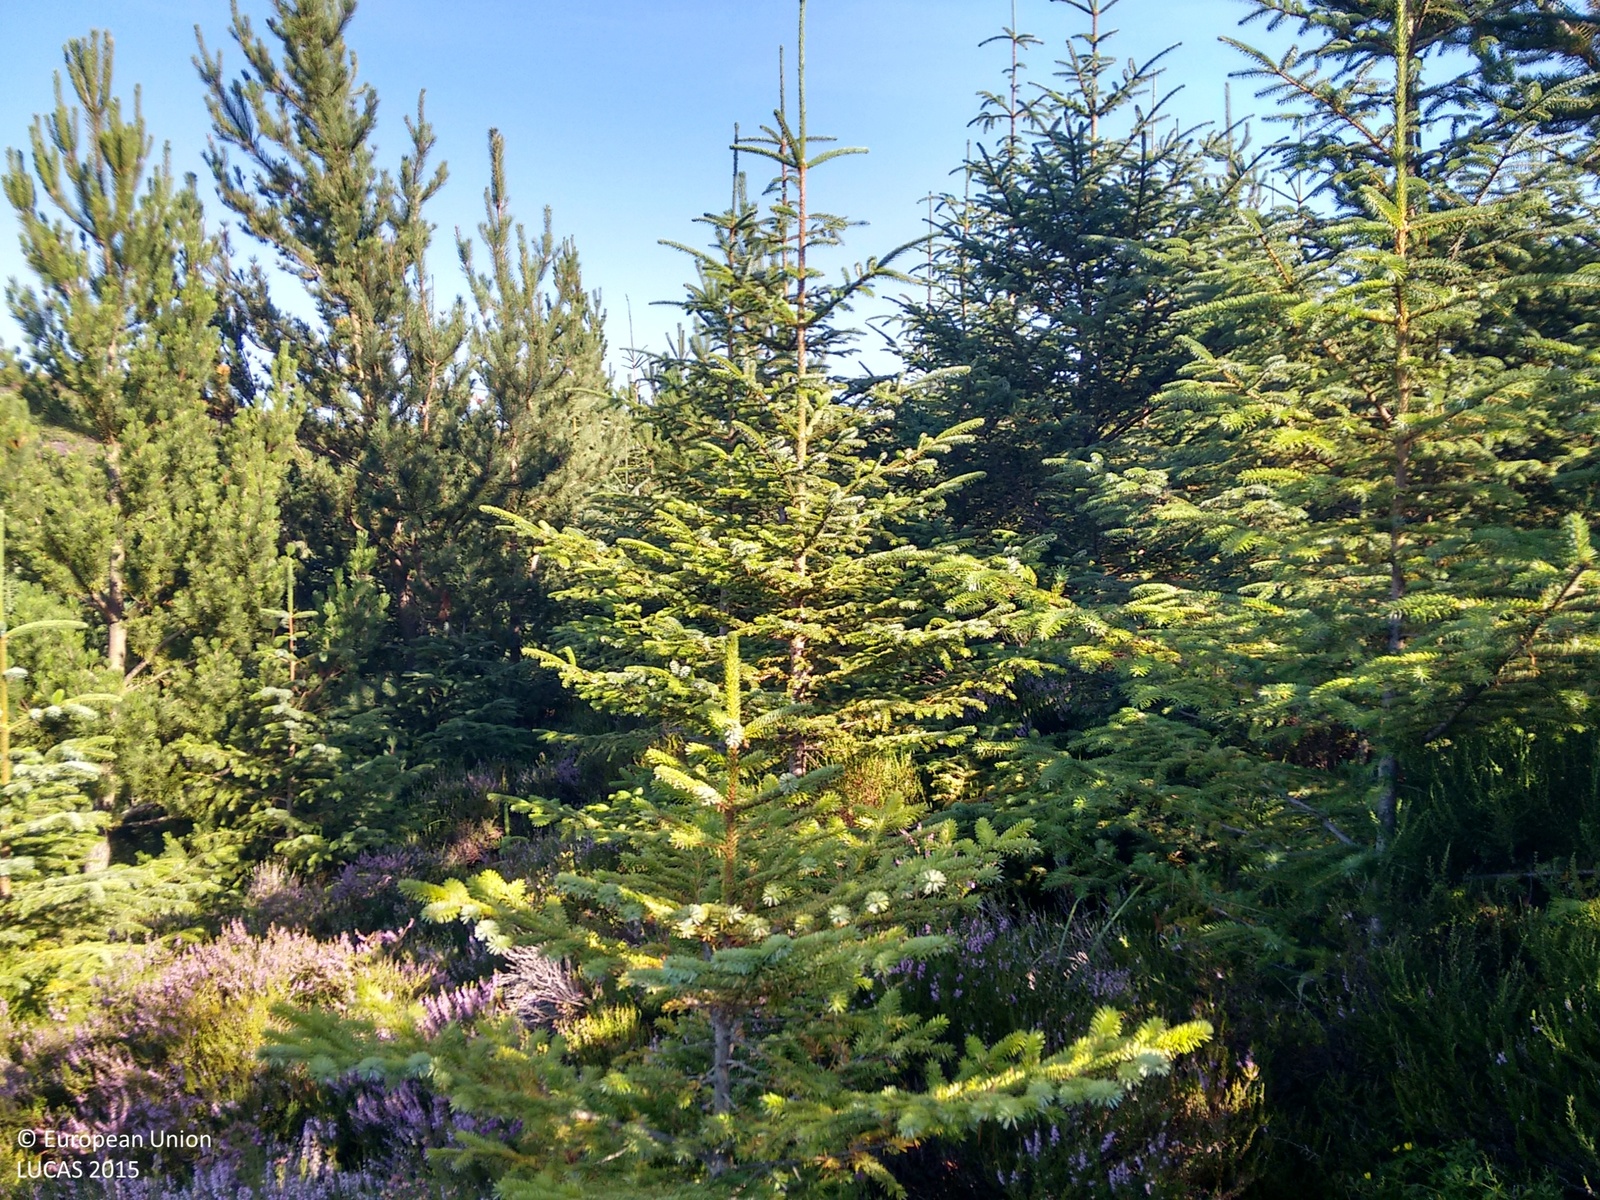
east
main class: Woodland
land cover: Spruce dominated coniferous woodland
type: exotic forest
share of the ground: > 75 %
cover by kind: coniferous forest trees 95 %, shrubs 5 %
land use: Forestry
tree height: > 5 m
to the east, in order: Spruce dominated coniferous woodland; Tracks; Spruce dominated coniferous woodland; Rivers and streams; Spruce dominated coniferous woodland
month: September
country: GB
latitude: 58.4790
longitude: -4.2622
